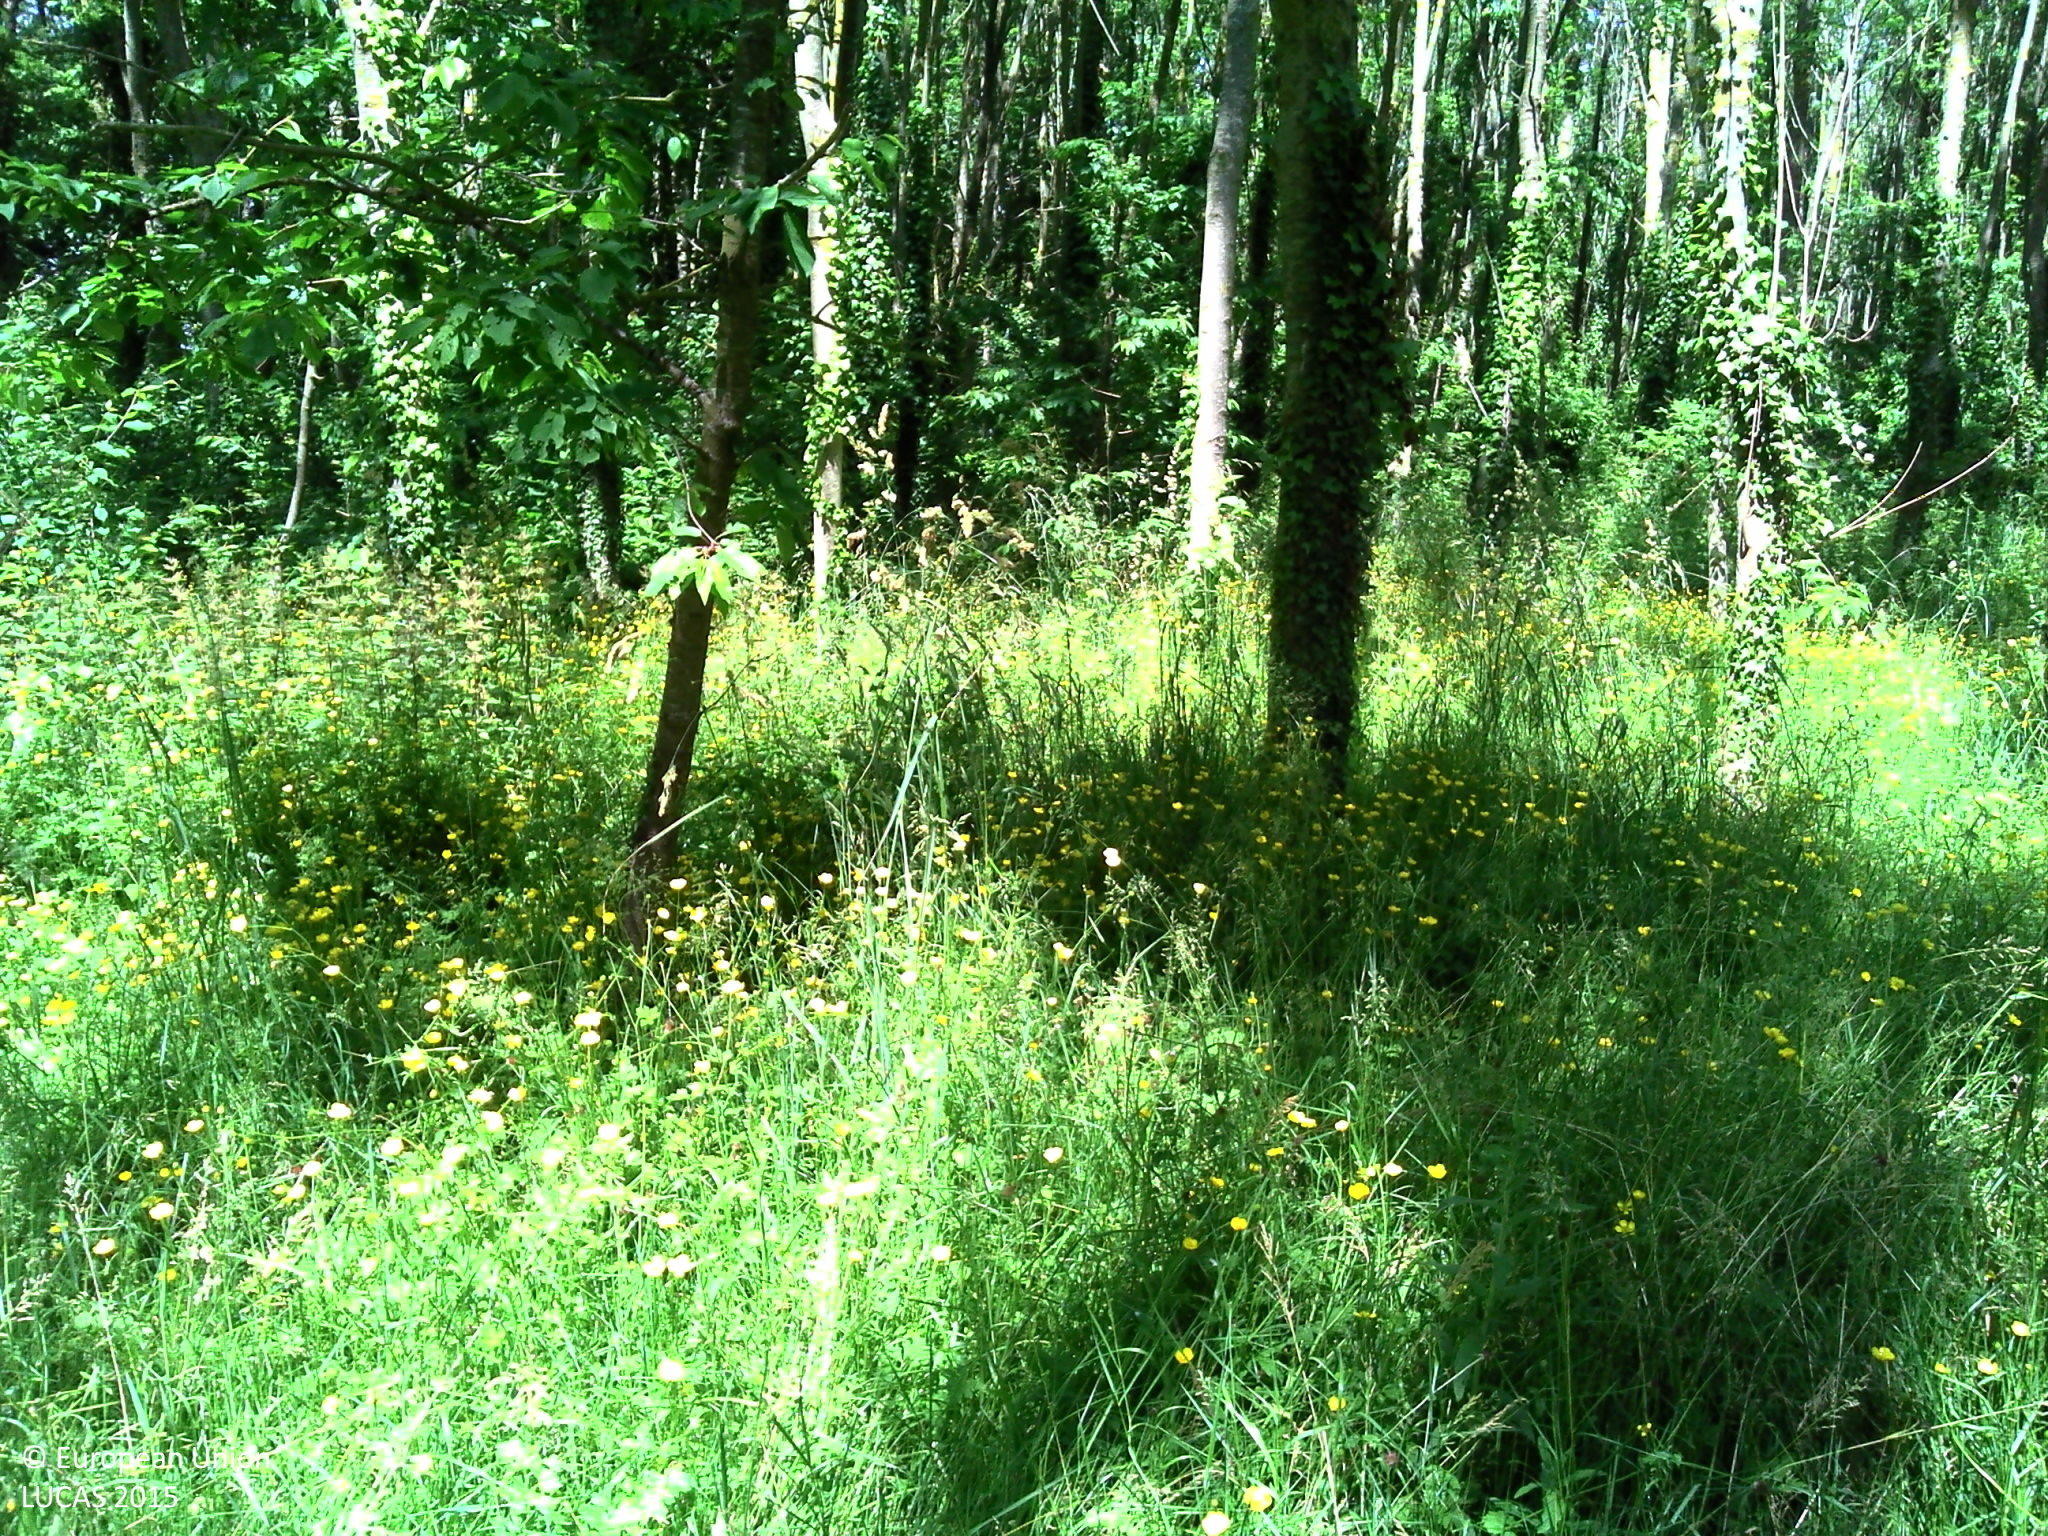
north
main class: Woodland
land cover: Broadleaved woodland
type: mesophytic deciduous forest
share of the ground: 50 - 75 %
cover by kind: broadleaved forest trees 60 %, herbaceous plants 20 %
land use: Forestry
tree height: > 5 m
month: June
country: FR
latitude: 50.7762
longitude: 2.0857
